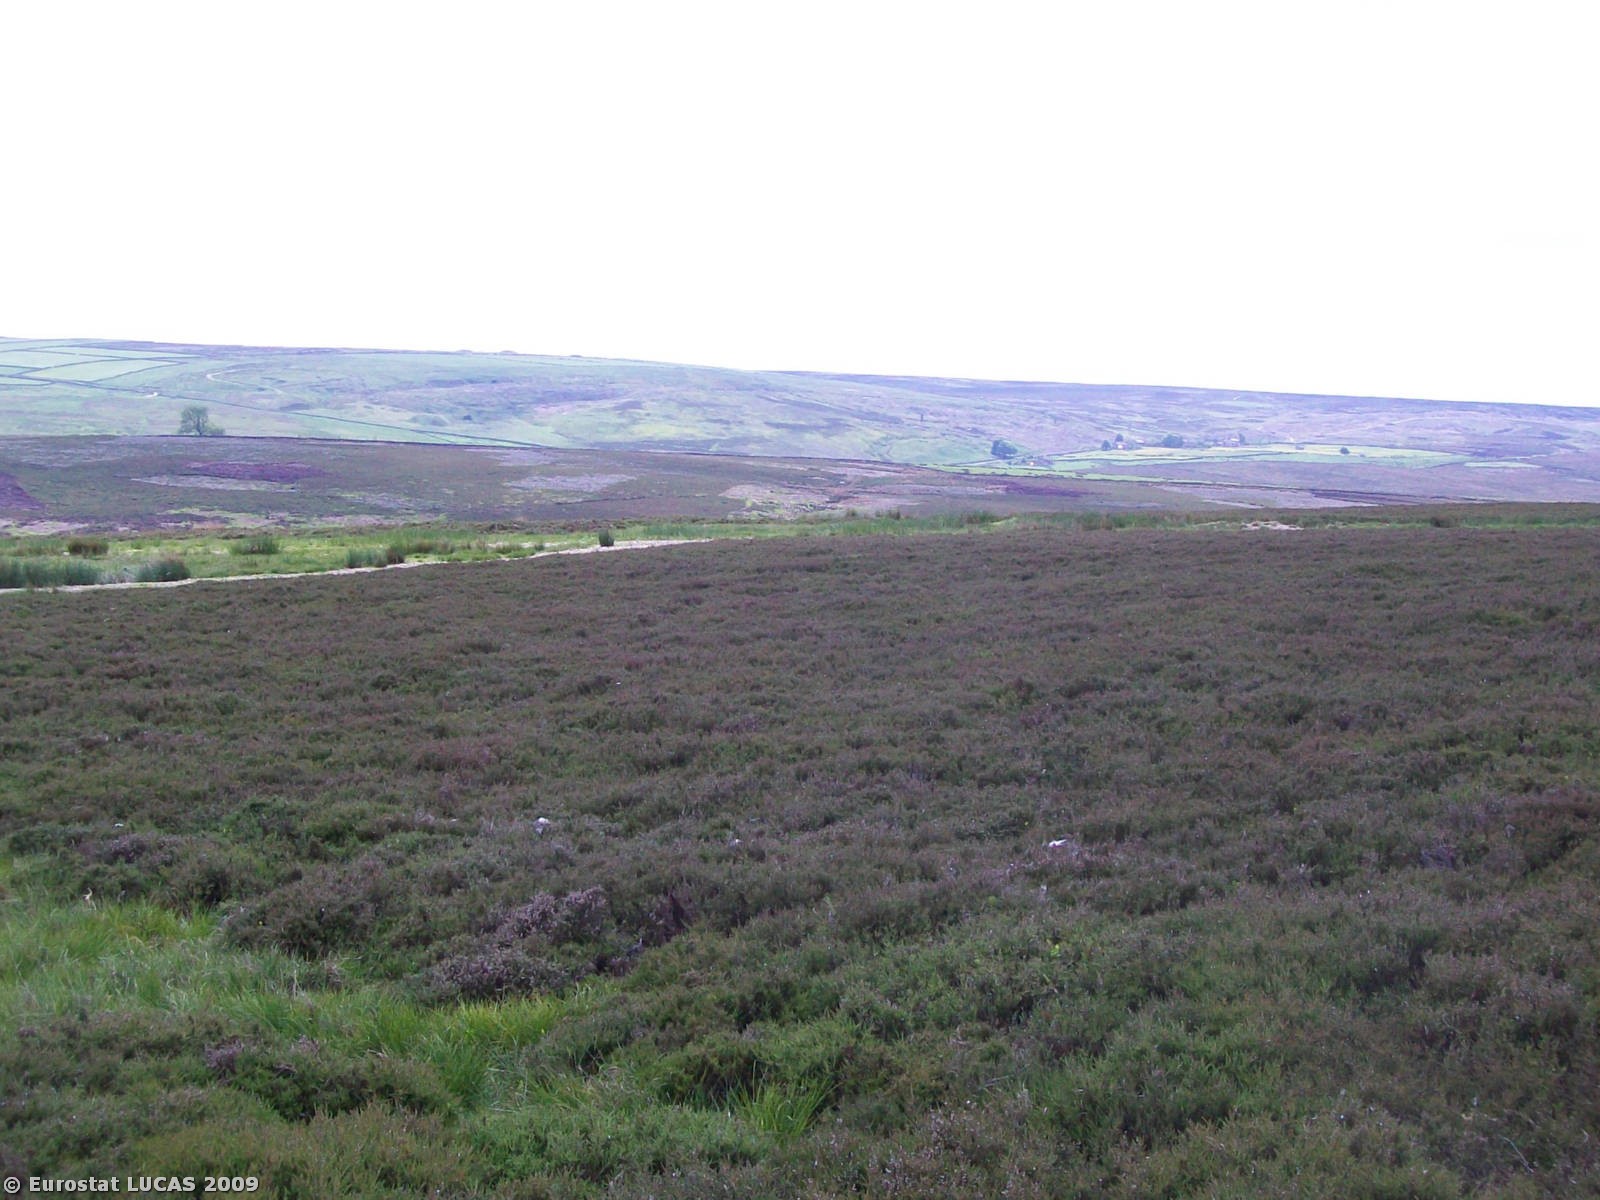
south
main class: Shrubland
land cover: Shrubland without tree cover
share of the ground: 50 - 75 %
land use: Agriculture (excluding fallow land and kitchen gardens)
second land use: Nature reserves
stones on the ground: < 10 %
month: June
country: GB
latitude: 54.4302
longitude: -1.9088
